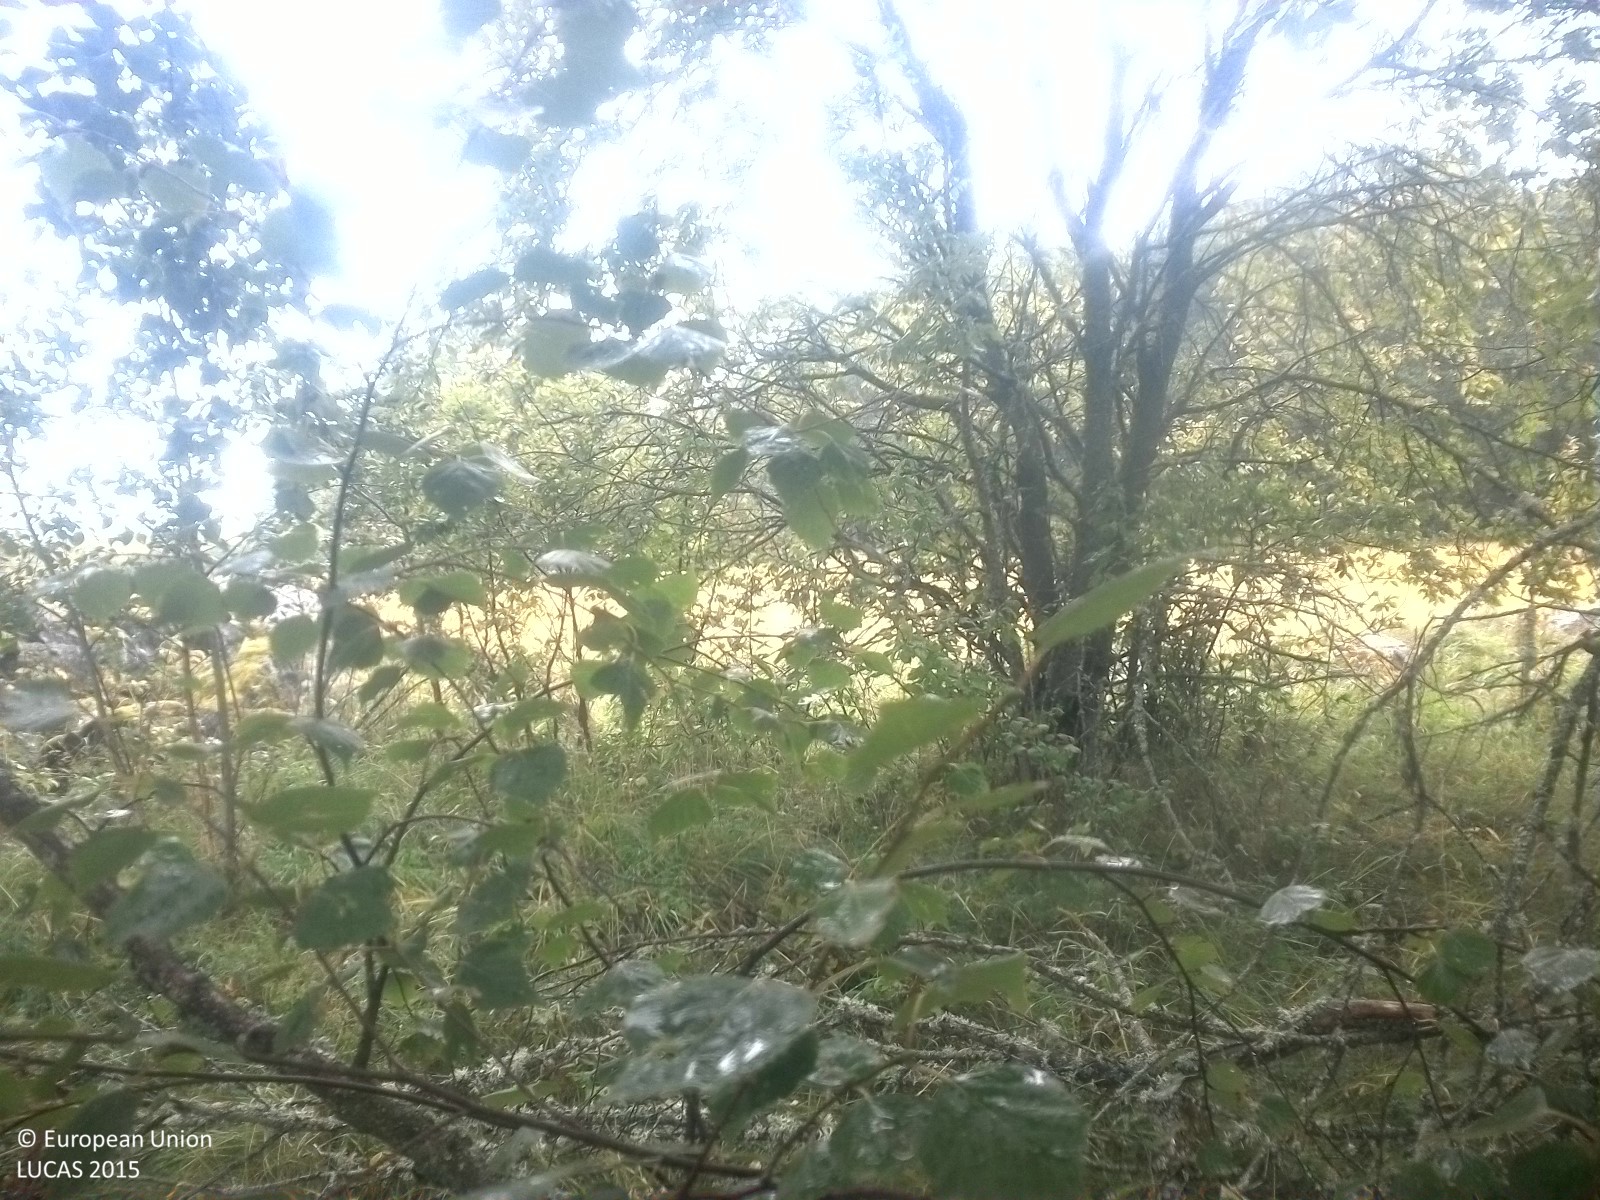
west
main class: Woodland
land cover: Broadleaved woodland
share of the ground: 50 - 75 %
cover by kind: broadleaved forest trees 60 %, herbaceous plants 30 %, shrubs 5 %, lichens and mosses 5 %
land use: Agriculture (excluding fallow land and kitchen gardens)
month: September
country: SE
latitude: 59.4061
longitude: 15.9283
